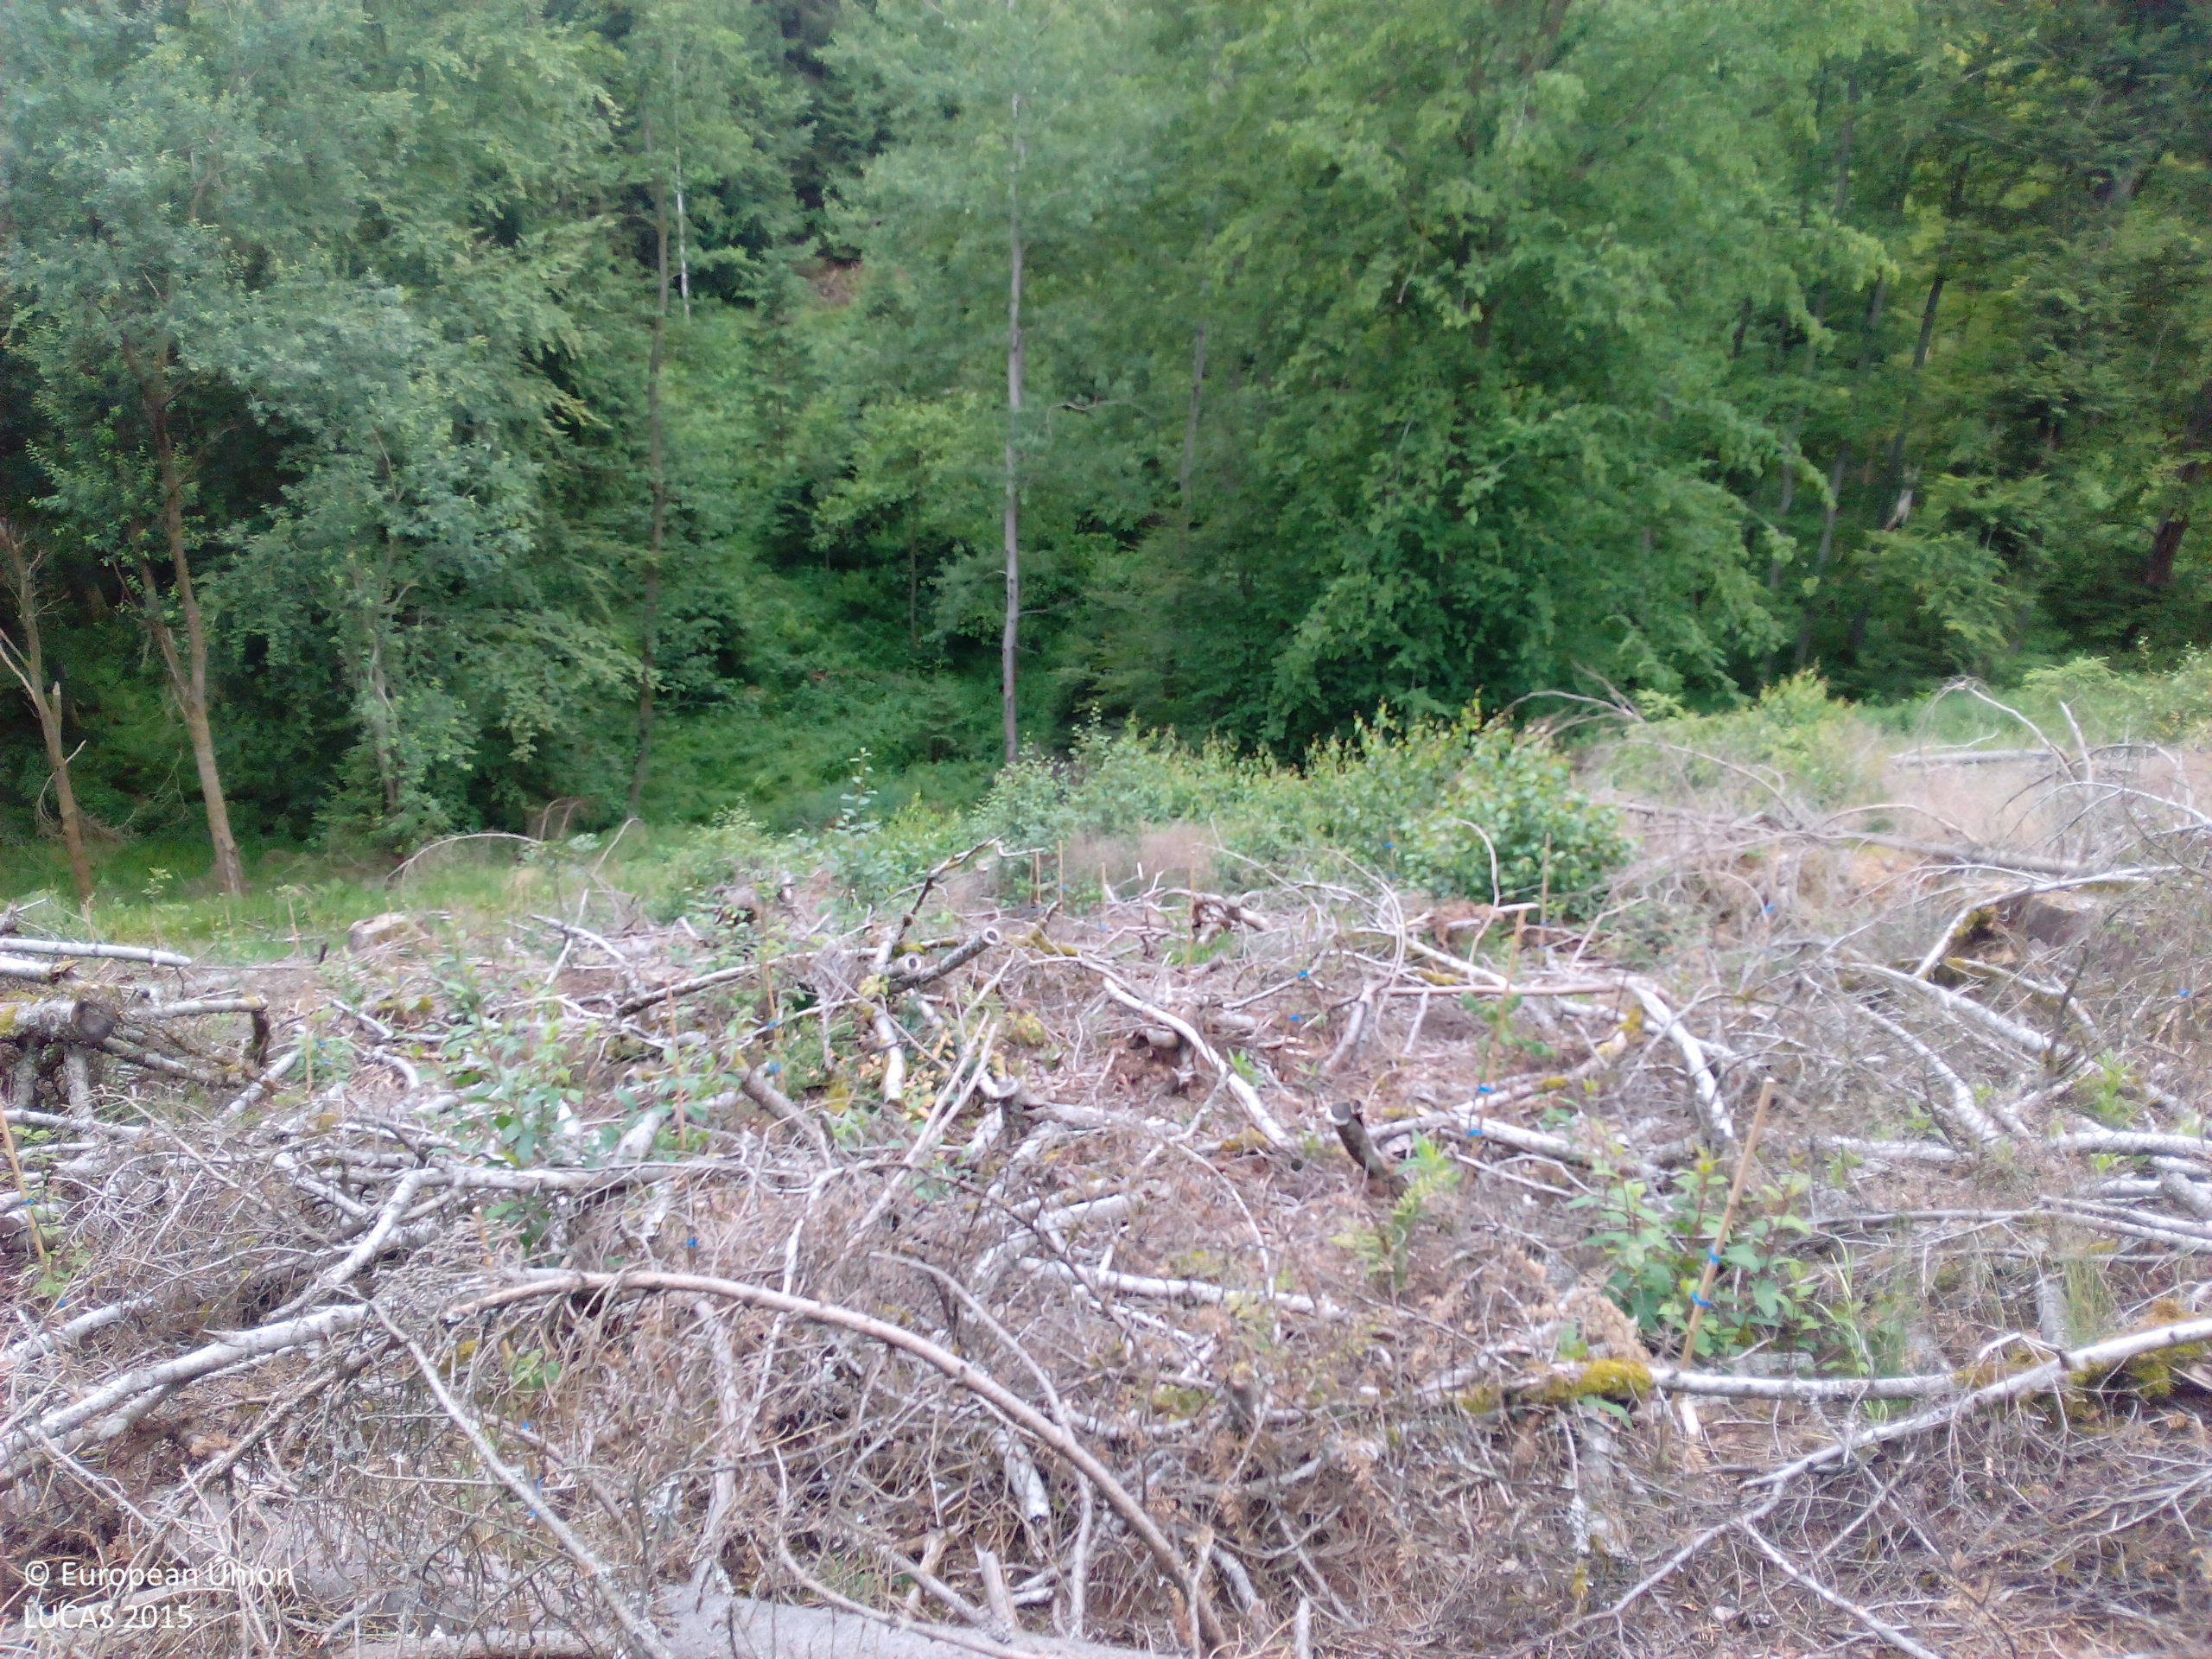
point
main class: Woodland
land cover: Broadleaved woodland
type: beech forest
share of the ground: 10 - 25 %
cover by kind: broadleaved forest trees 10 %, herbaceous plants 5 %, lichens and mosses 5 %
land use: Forestry
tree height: < 5 m
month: June
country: DE
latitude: 49.0070
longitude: 12.4191
